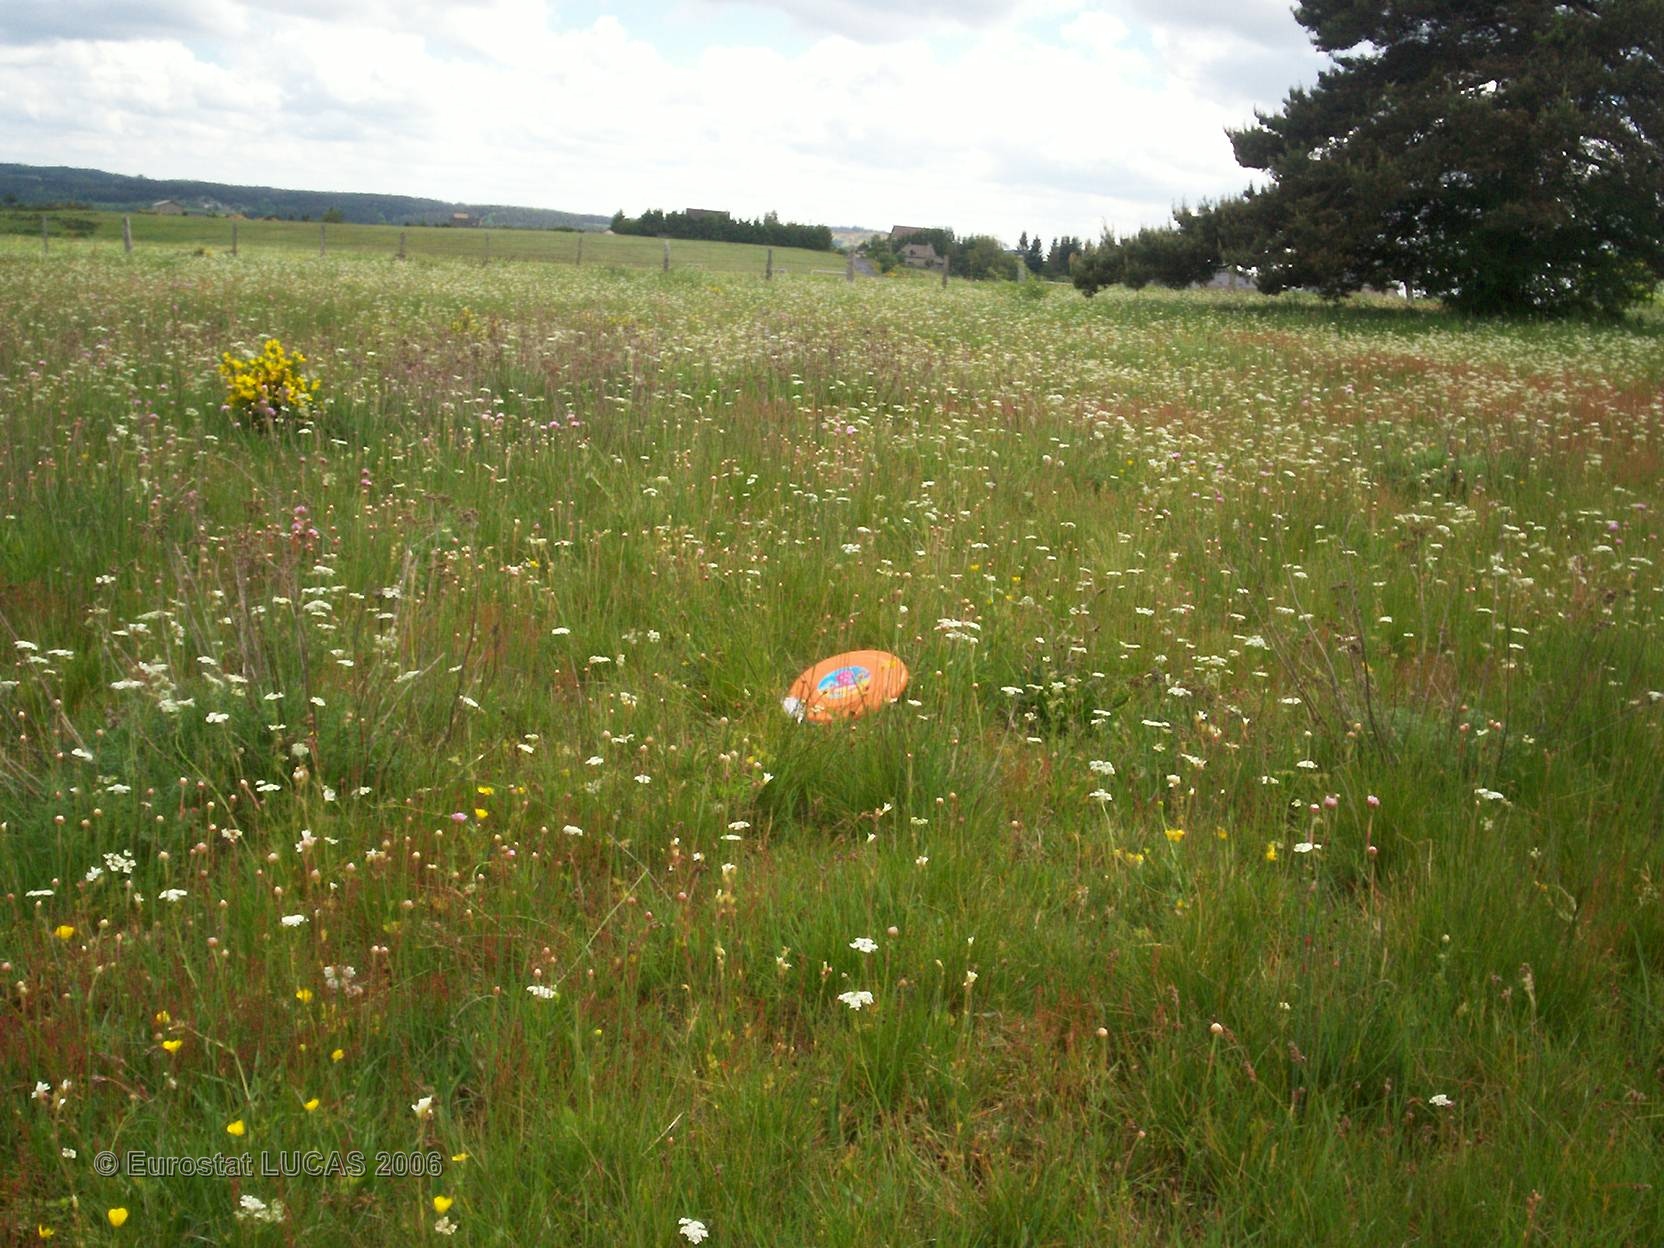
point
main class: Grassland
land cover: Grassland without tree/shrub cover
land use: Agriculture (excluding fallow land and kitchen gardens)
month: May
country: FR
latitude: 44.7911
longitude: 3.3932
